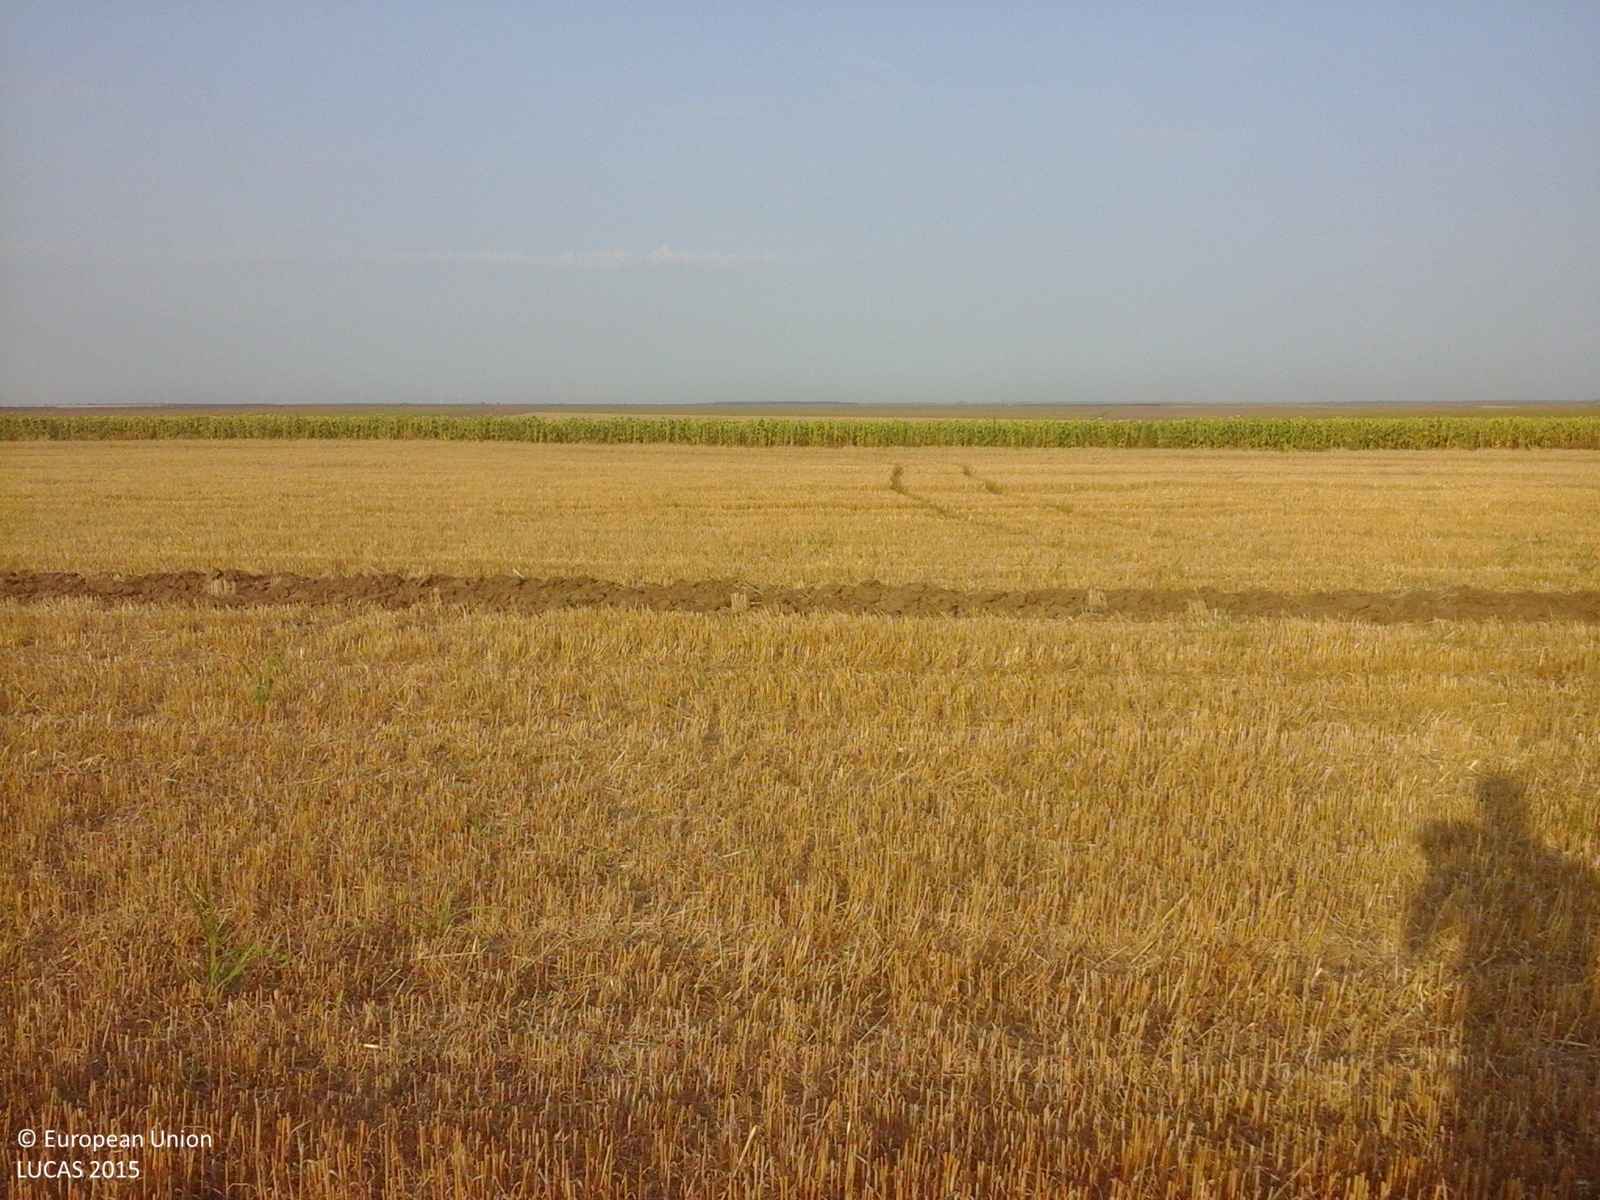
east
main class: Cropland
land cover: Barley
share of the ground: > 75 %
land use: Agriculture (excluding fallow land and kitchen gardens)
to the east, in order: Barley; Grass margins; Tracks; Grass margins; Sunflower
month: August
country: RO
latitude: 44.0406
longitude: 28.0622
